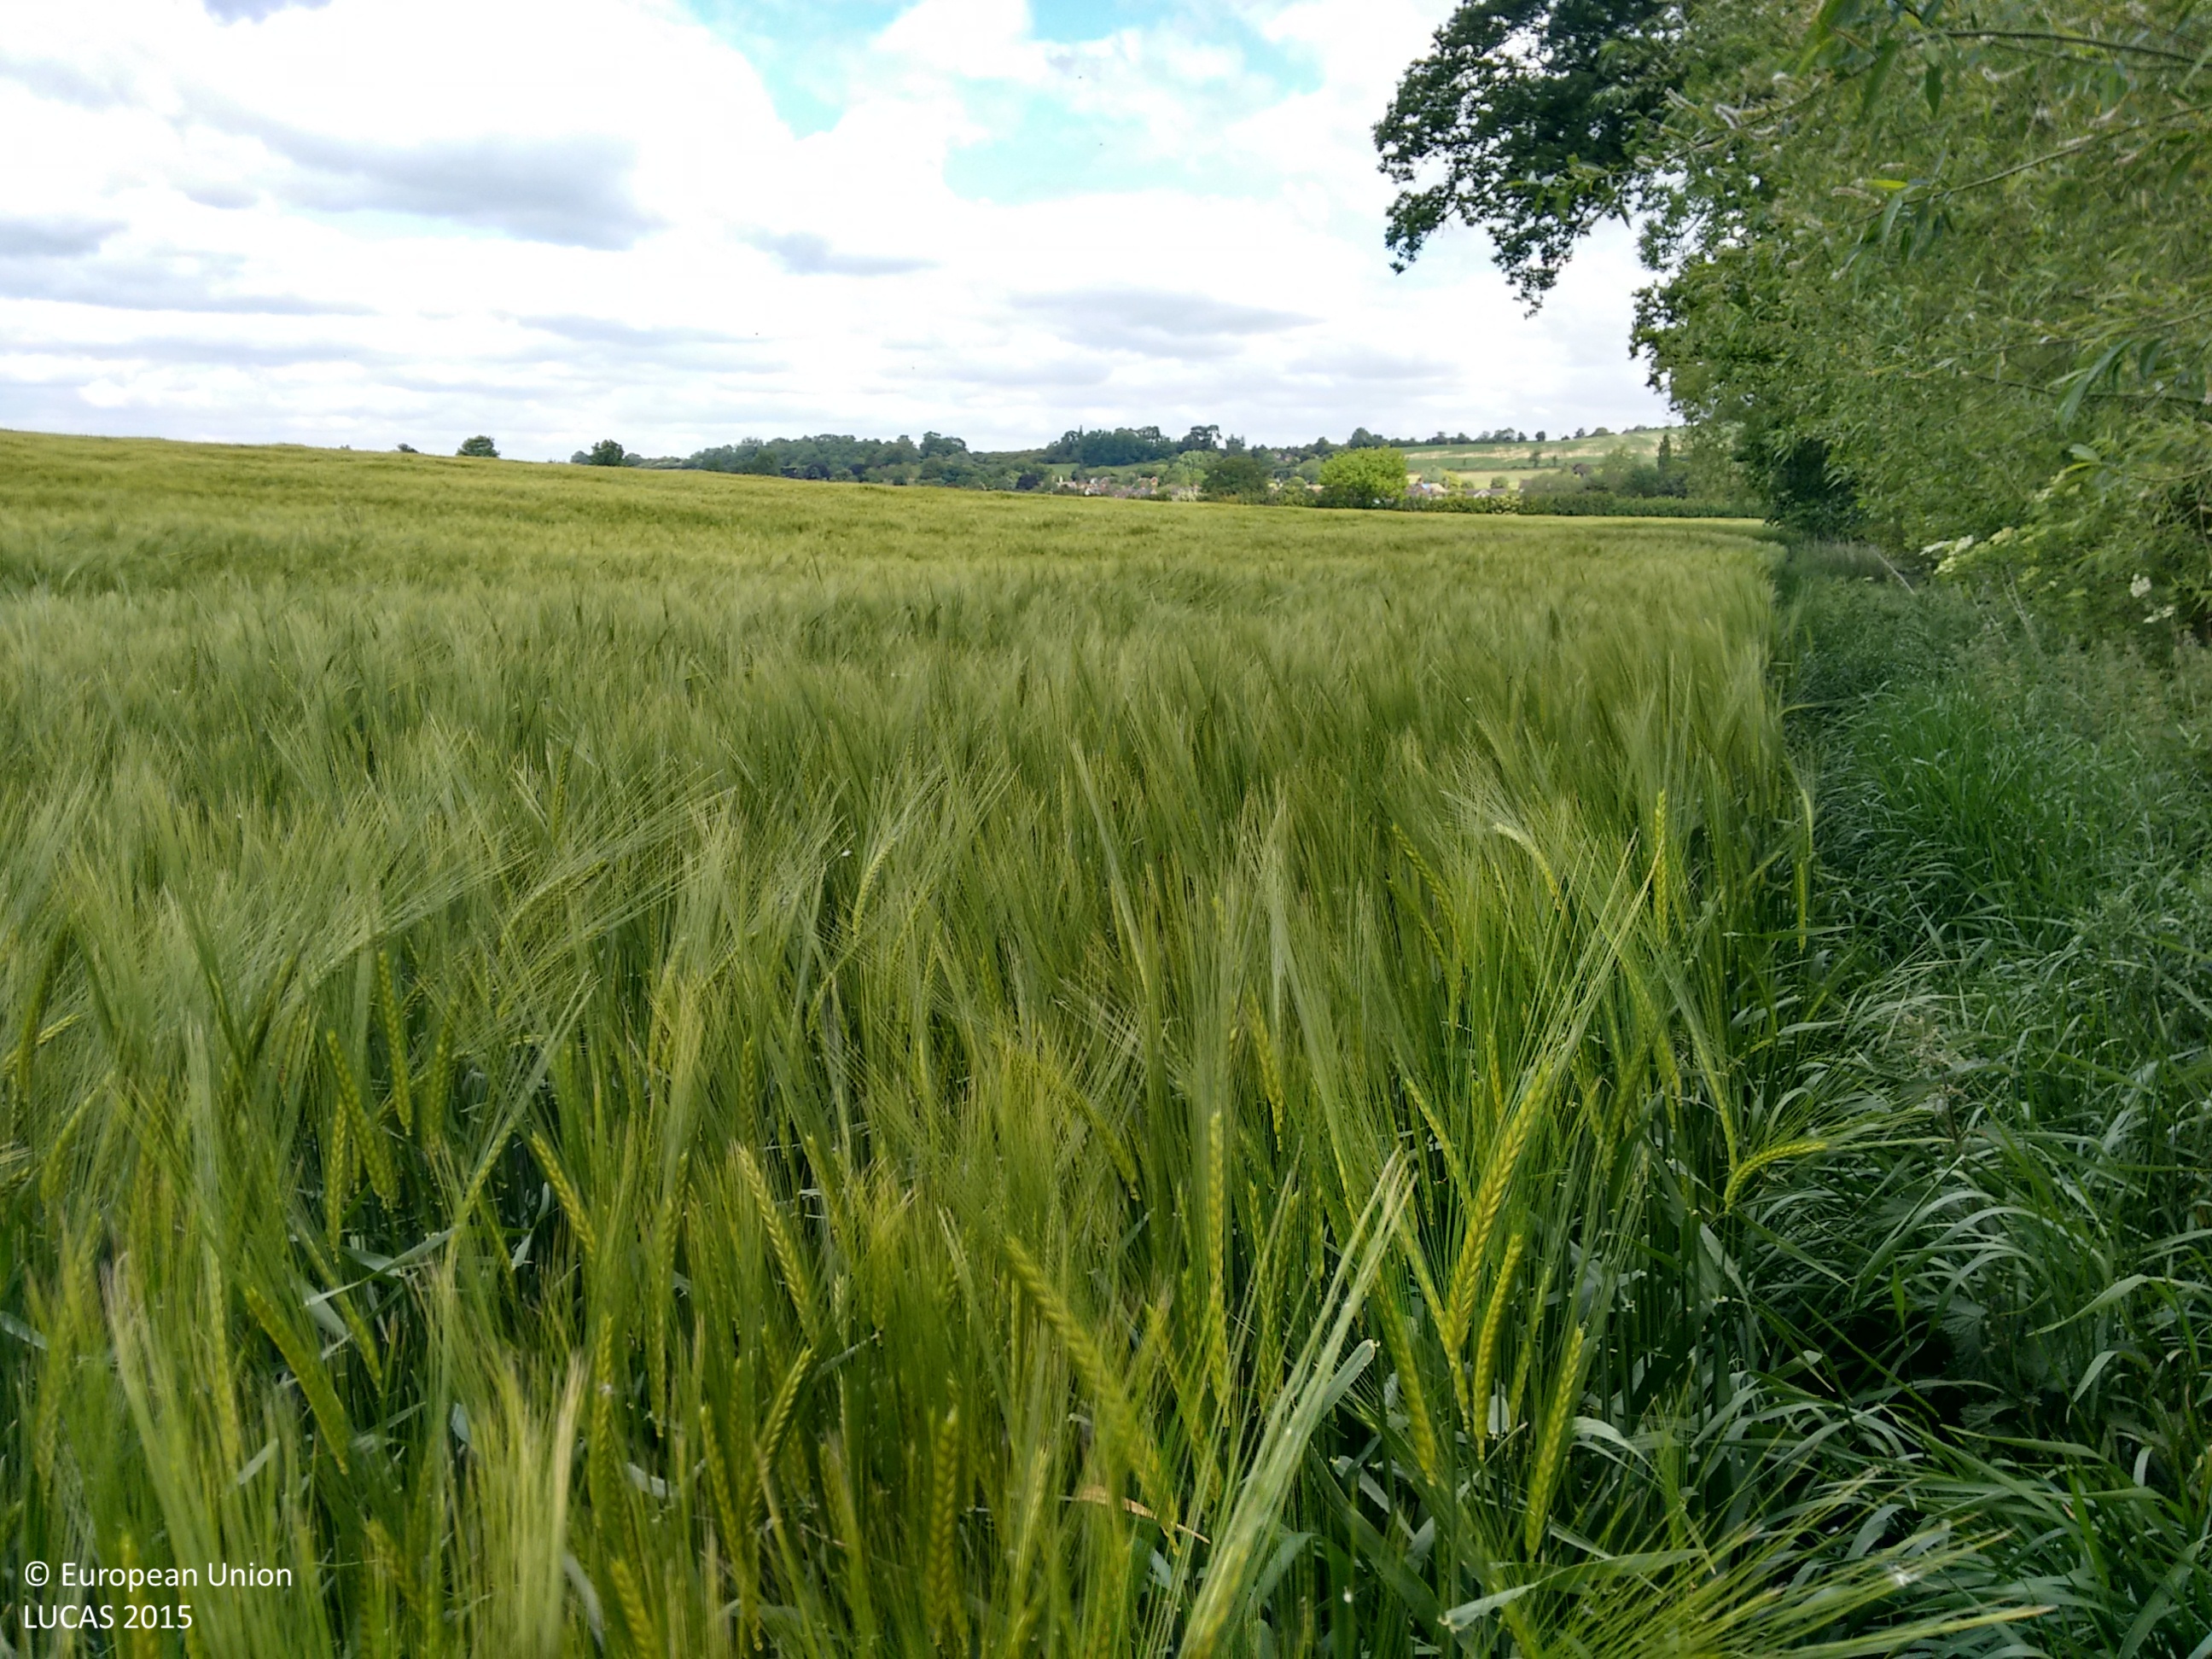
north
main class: Cropland
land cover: Barley
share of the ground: > 75 %
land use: Agriculture (excluding fallow land and kitchen gardens)
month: June
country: GB
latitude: 52.1270
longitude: -1.6662
